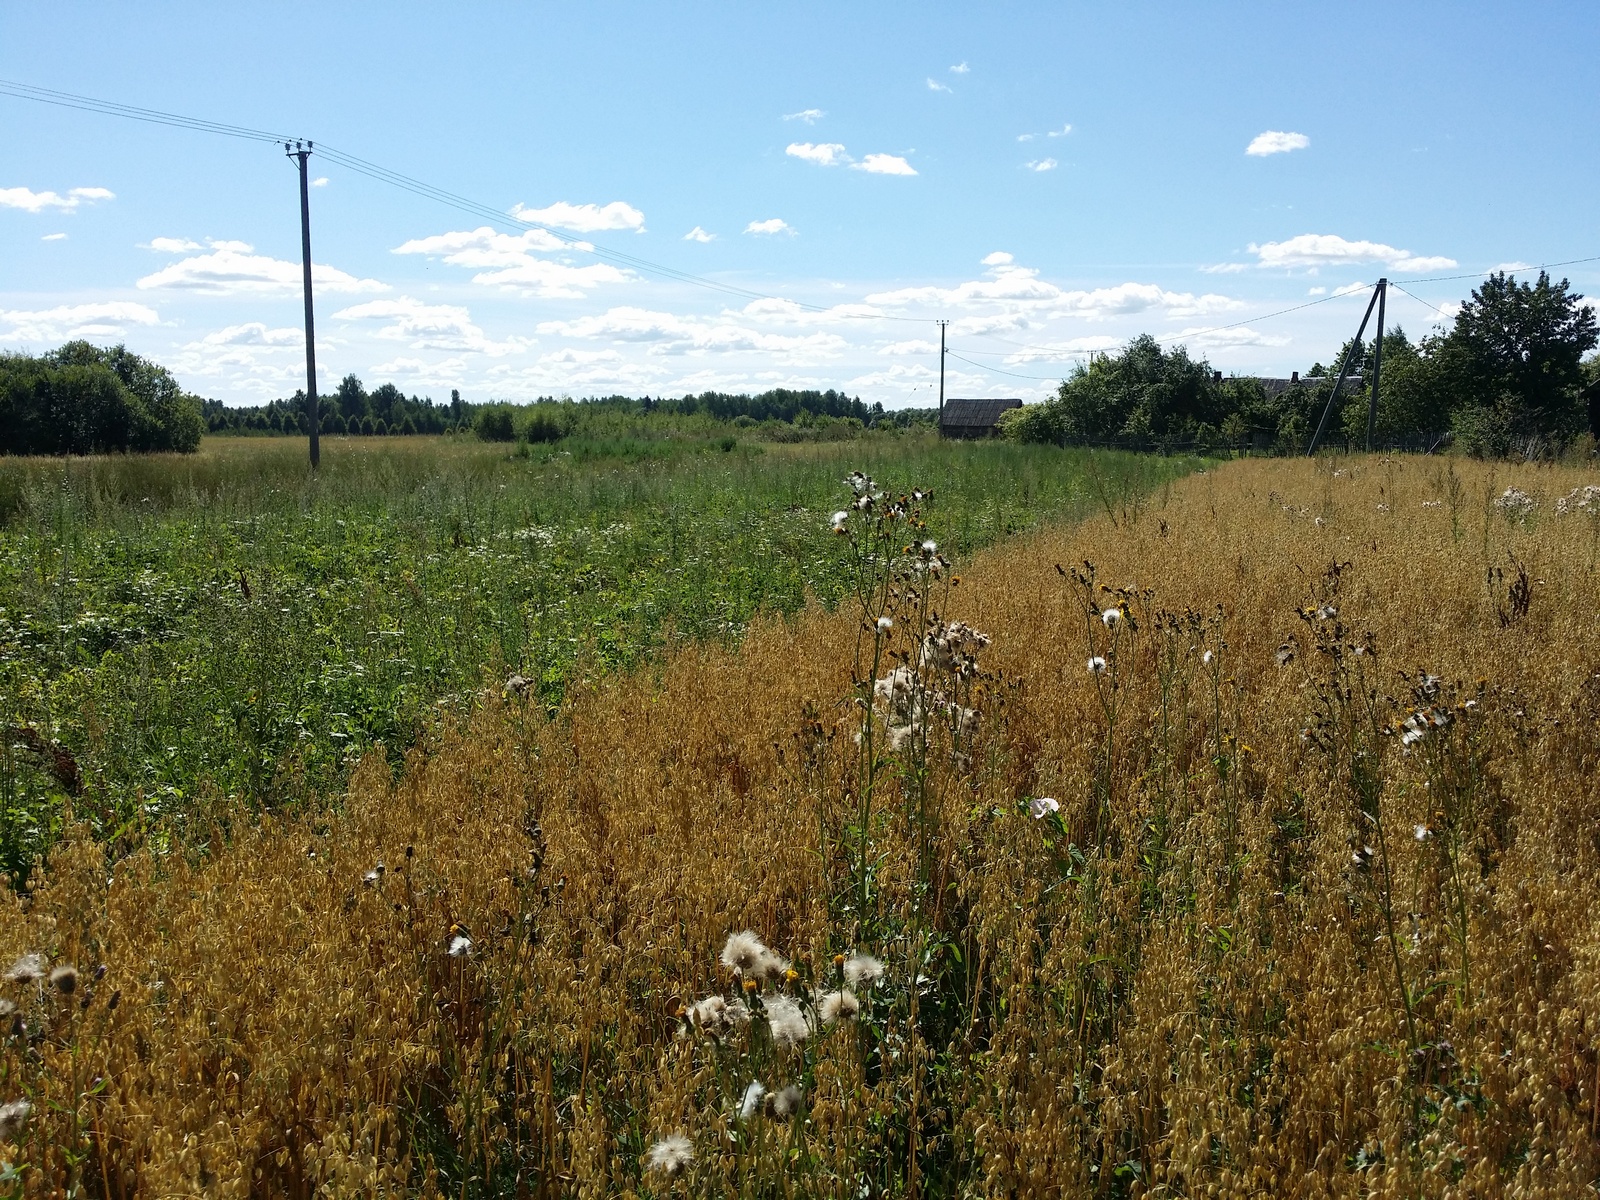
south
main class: Cropland
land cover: Oats
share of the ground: > 75 %
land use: Agriculture (excluding fallow land and kitchen gardens)
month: August
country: LV
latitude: 57.0386
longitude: 27.6331
